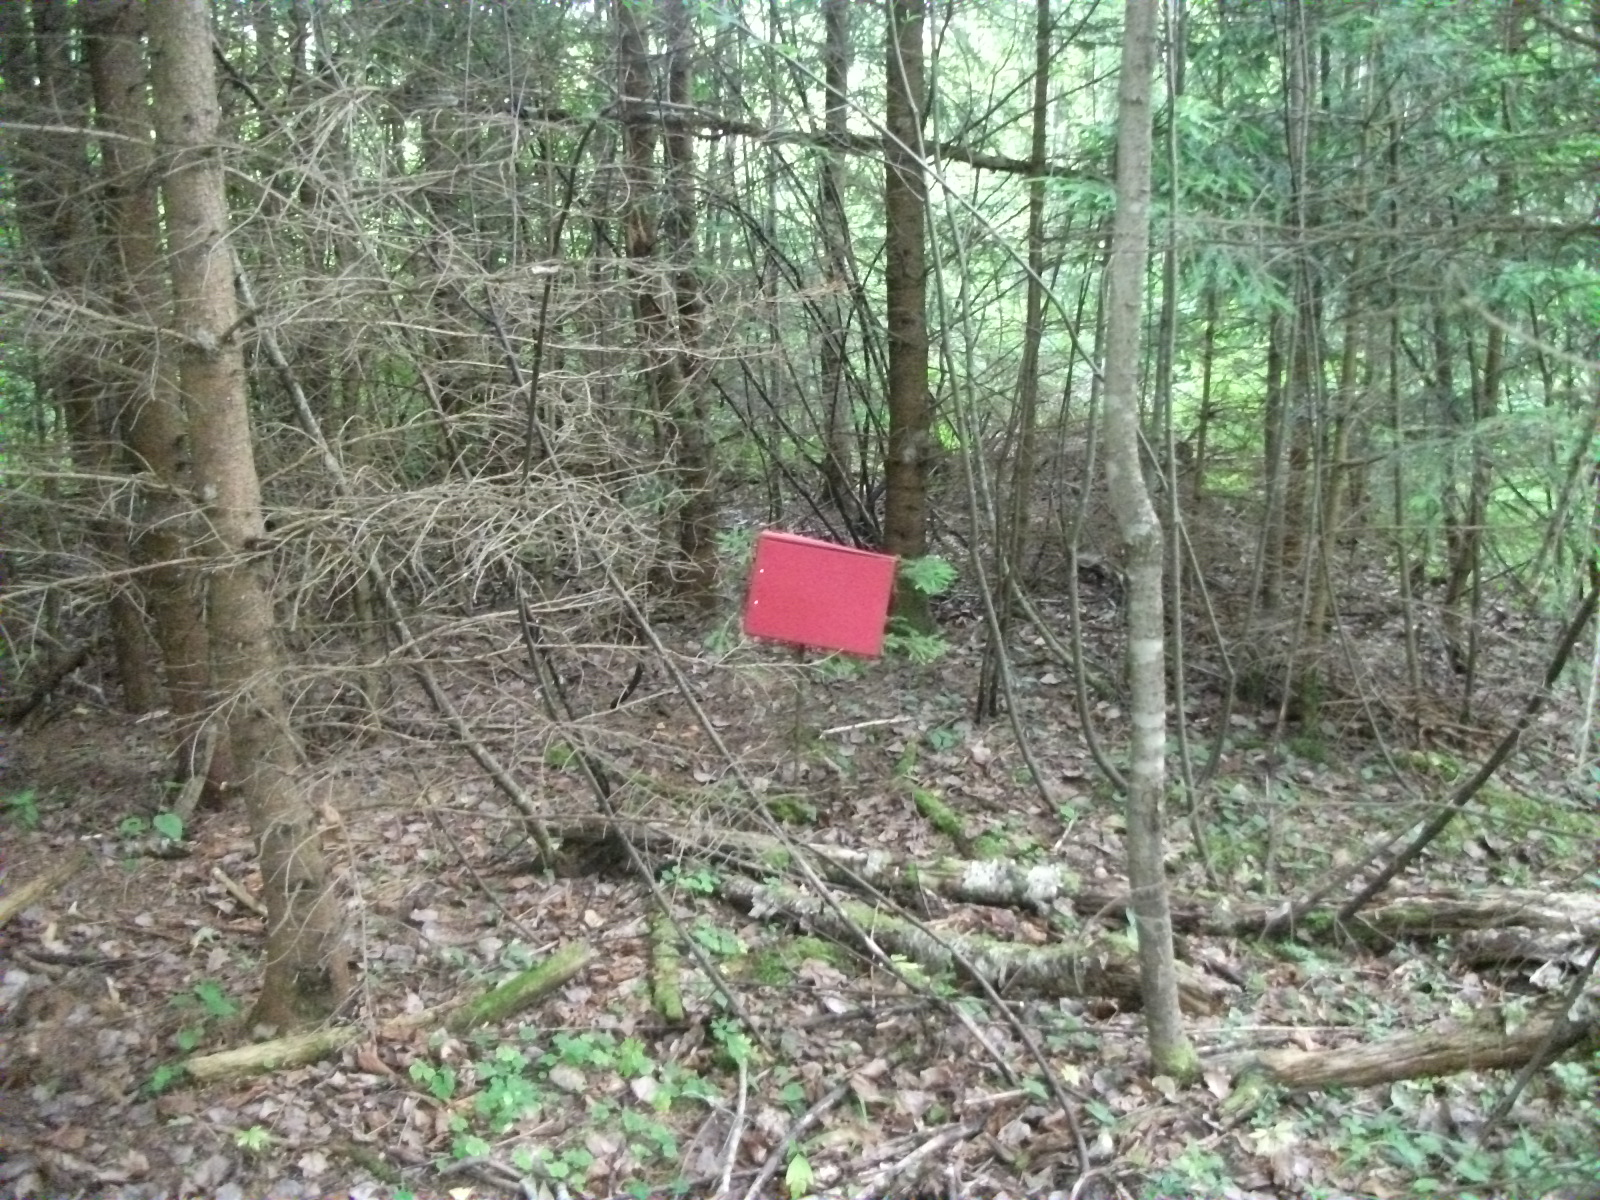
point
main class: Woodland
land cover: Spruce dominated coniferous woodland
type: hemiboreal forest and nemoral coniferous forest and mixed broadleaved-coniferous forest
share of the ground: > 75 %
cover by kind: coniferous forest trees 90 %, herbaceous plants 5 %, unconsolidated bare surface 5 %
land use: Forestry
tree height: > 5 m
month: July
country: LV
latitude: 57.1833
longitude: 26.5408
